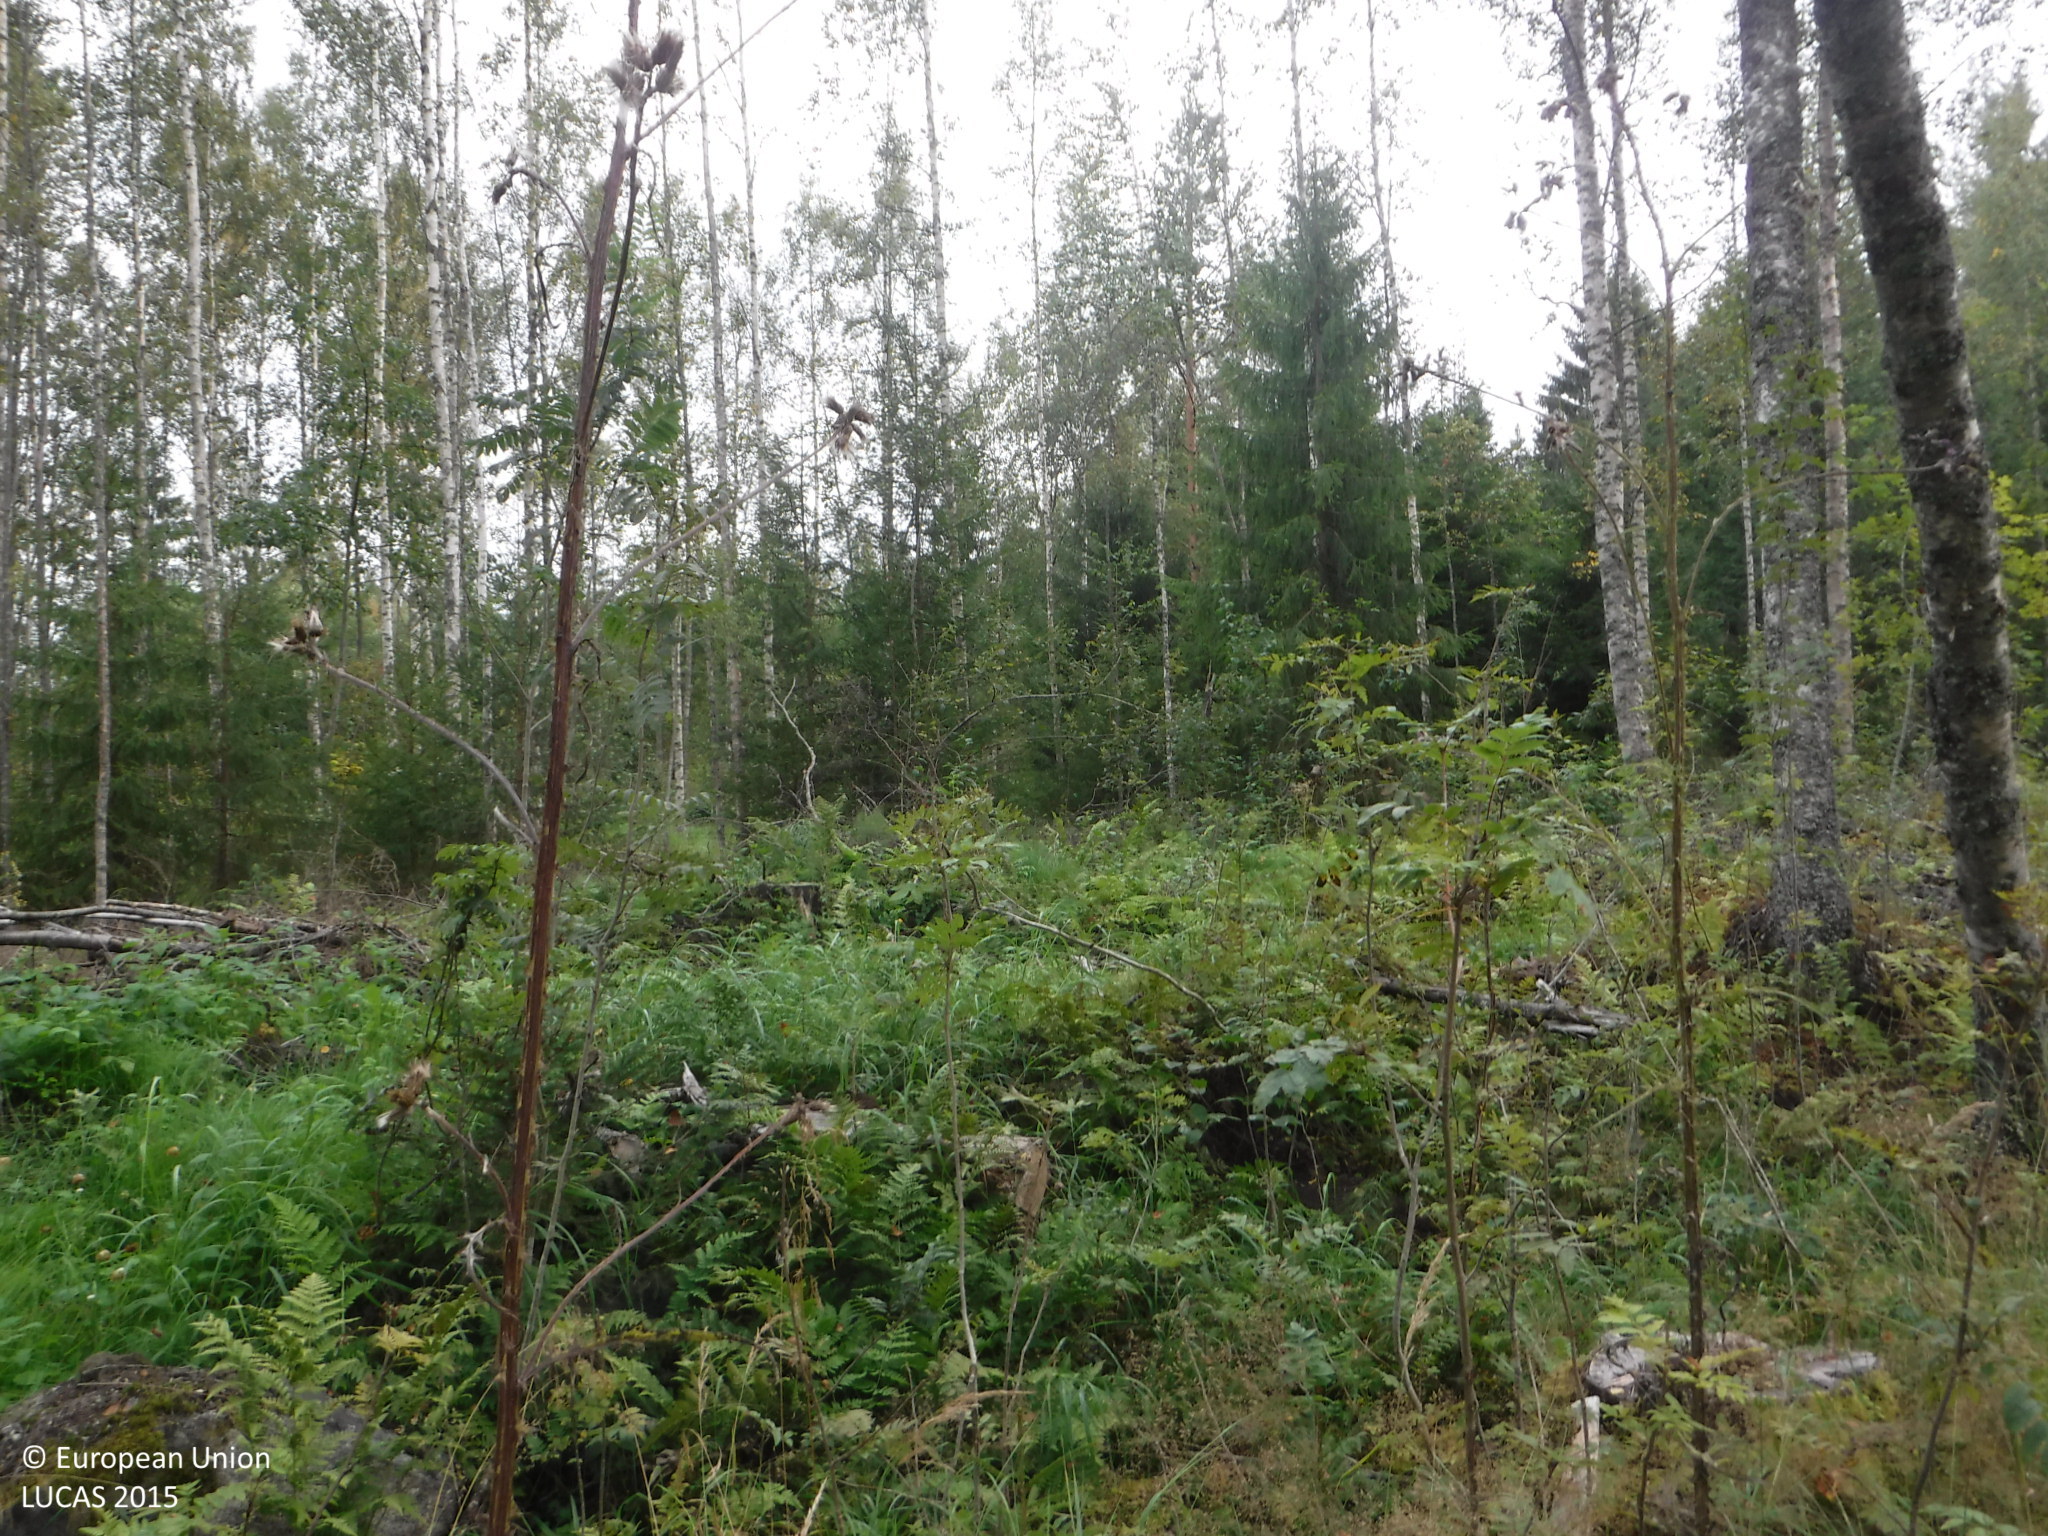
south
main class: Woodland
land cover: Broadleaved woodland
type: non-riverine alder, birch or aspen forest
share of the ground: 25 - 50 %
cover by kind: herbaceous plants 60 %, broadleaved forest trees 35 %, shrubs 5 %
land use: Forestry
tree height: > 5 m
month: September
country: FI
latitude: 61.3479
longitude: 21.9662
